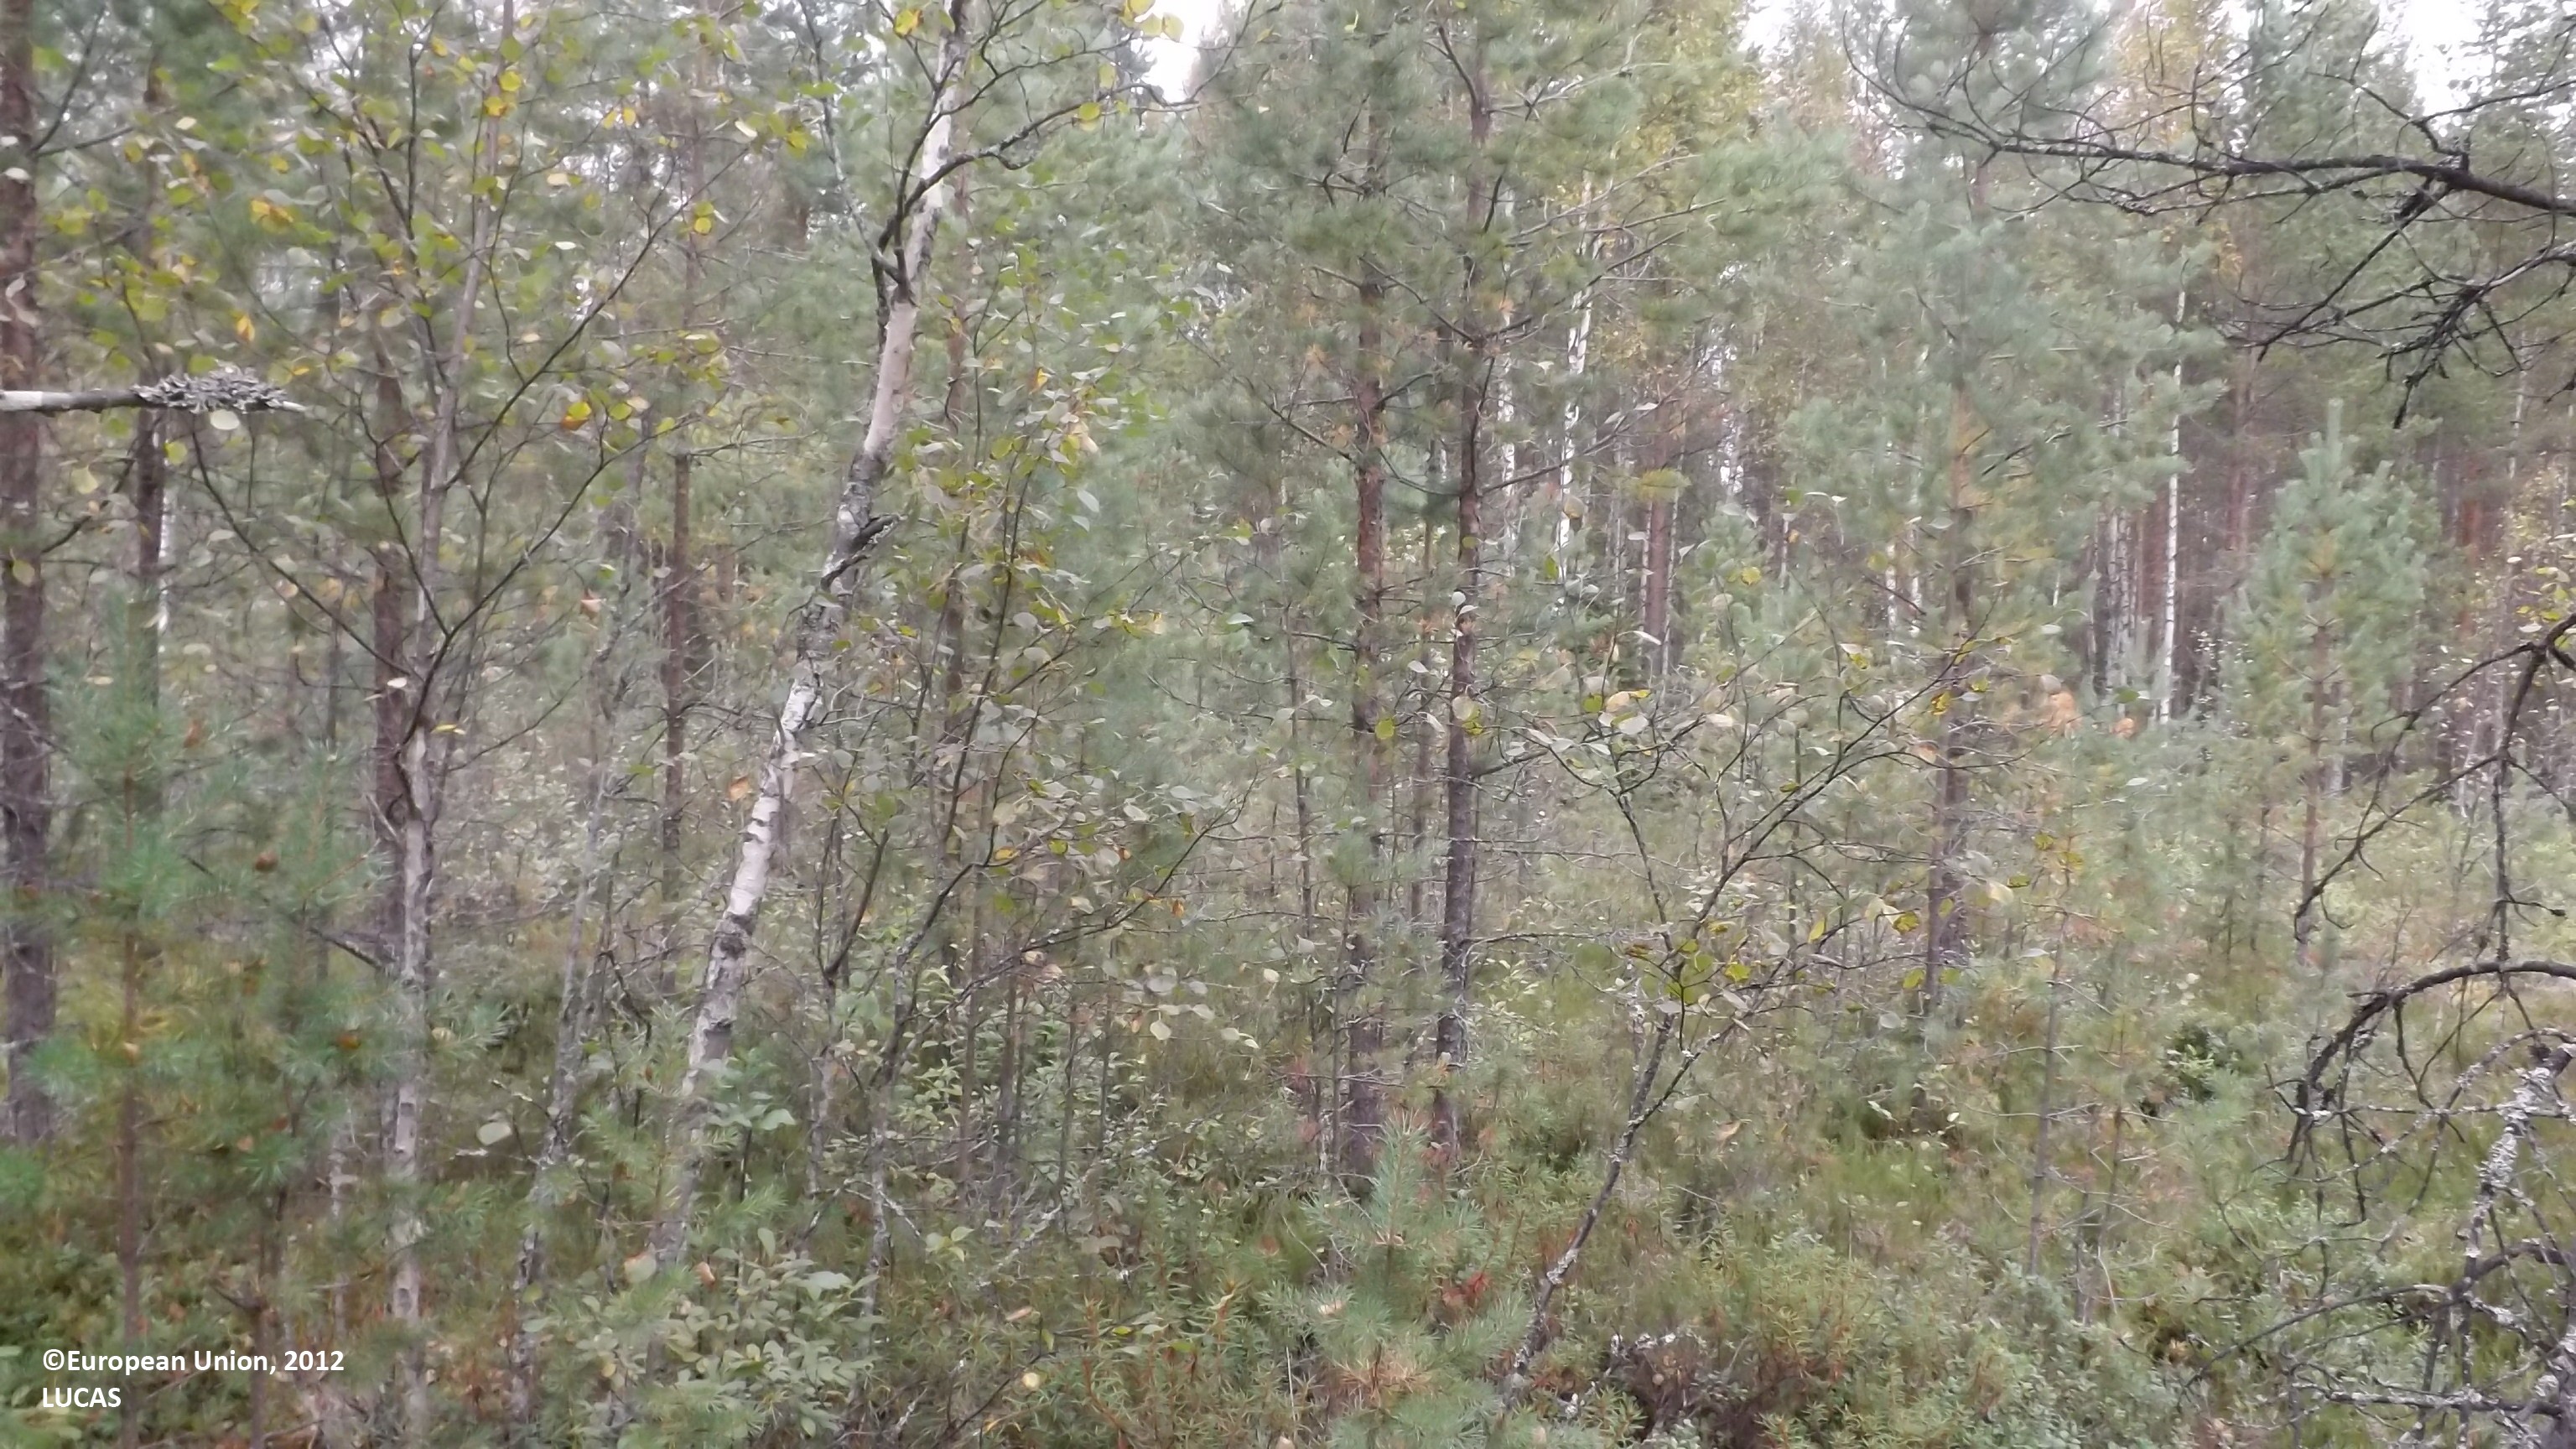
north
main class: Woodland
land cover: Pine dominated mixed woodland
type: boreal forest
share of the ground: 50 - 75 %
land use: Forestry
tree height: > 5 m
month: August
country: FI
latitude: 63.7734
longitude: 24.0014
